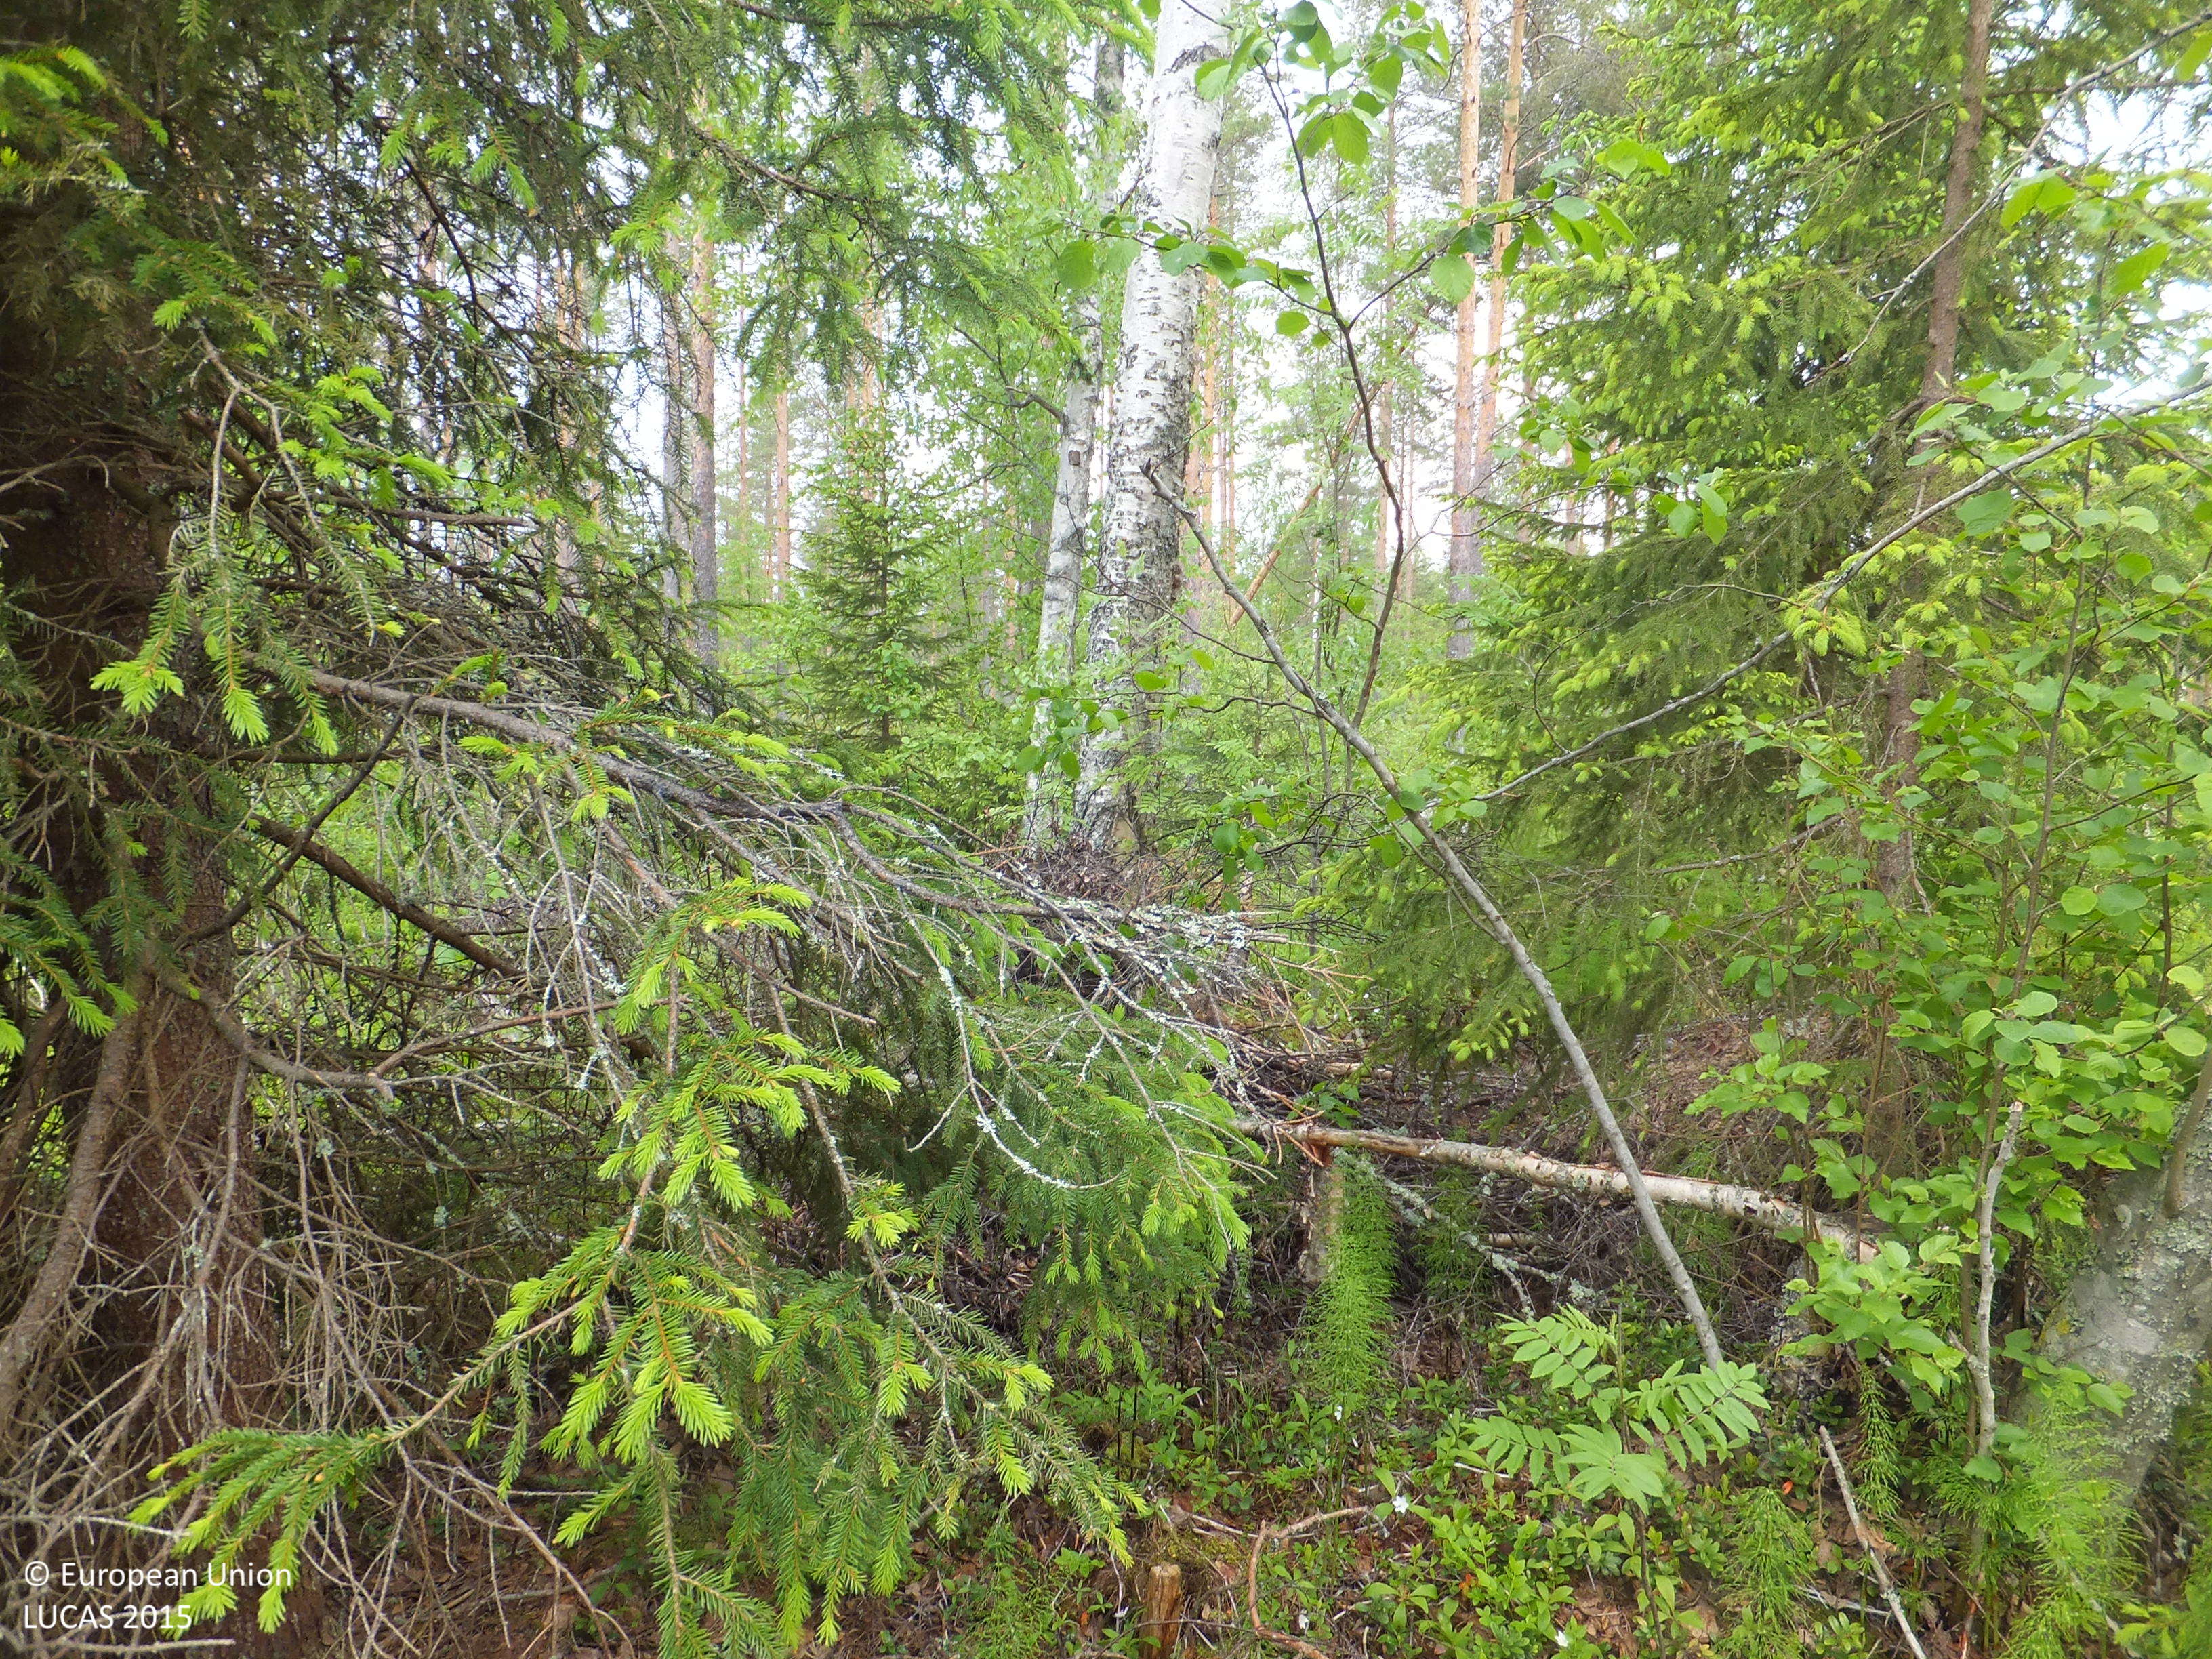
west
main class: Woodland
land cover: Other mixed woodland
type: boreal forest
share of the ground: 50 - 75 %
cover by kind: coniferous forest trees 35 %, broadleaved forest trees 35 %, shrubs 20 %, herbaceous plants 5 %, lichens and mosses 5 %
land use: Forestry
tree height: > 5 m
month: June
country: FI
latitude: 63.6433
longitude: 24.8023
